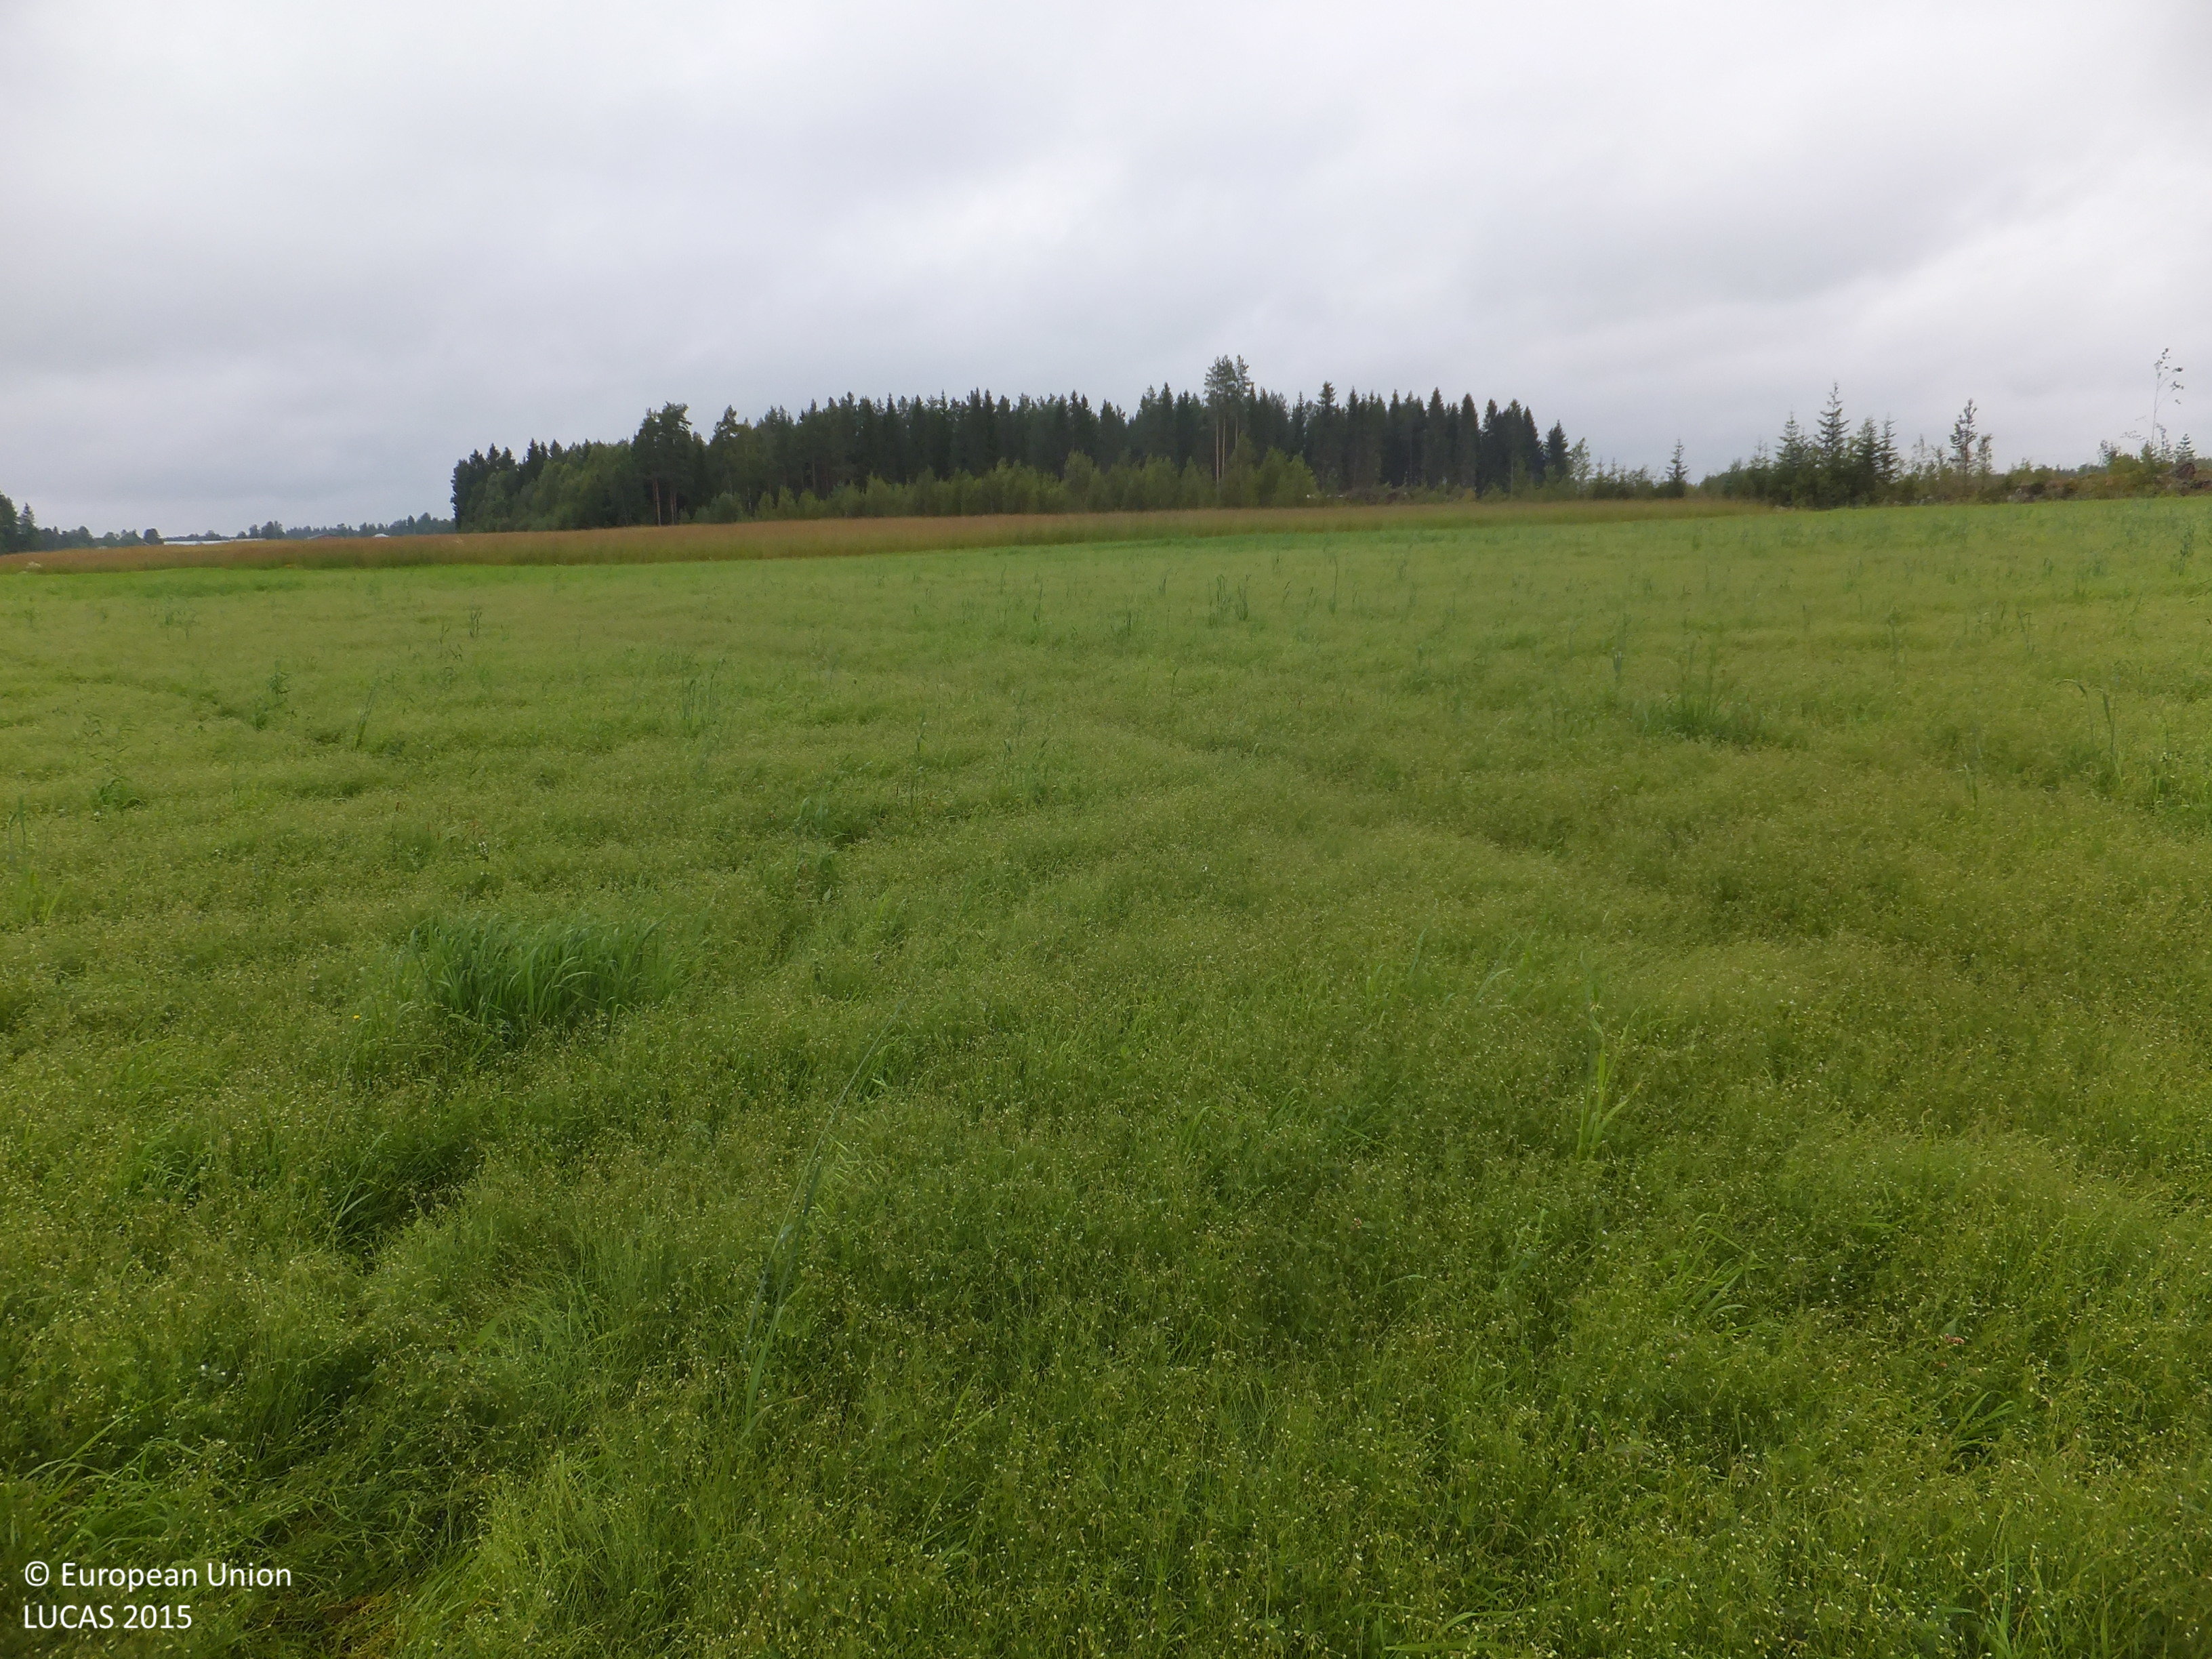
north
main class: Cropland
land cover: Temporary grasslands
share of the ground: > 75 %
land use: Agriculture (excluding fallow land and kitchen gardens)
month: August
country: FI
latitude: 63.3032
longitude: 23.0851
